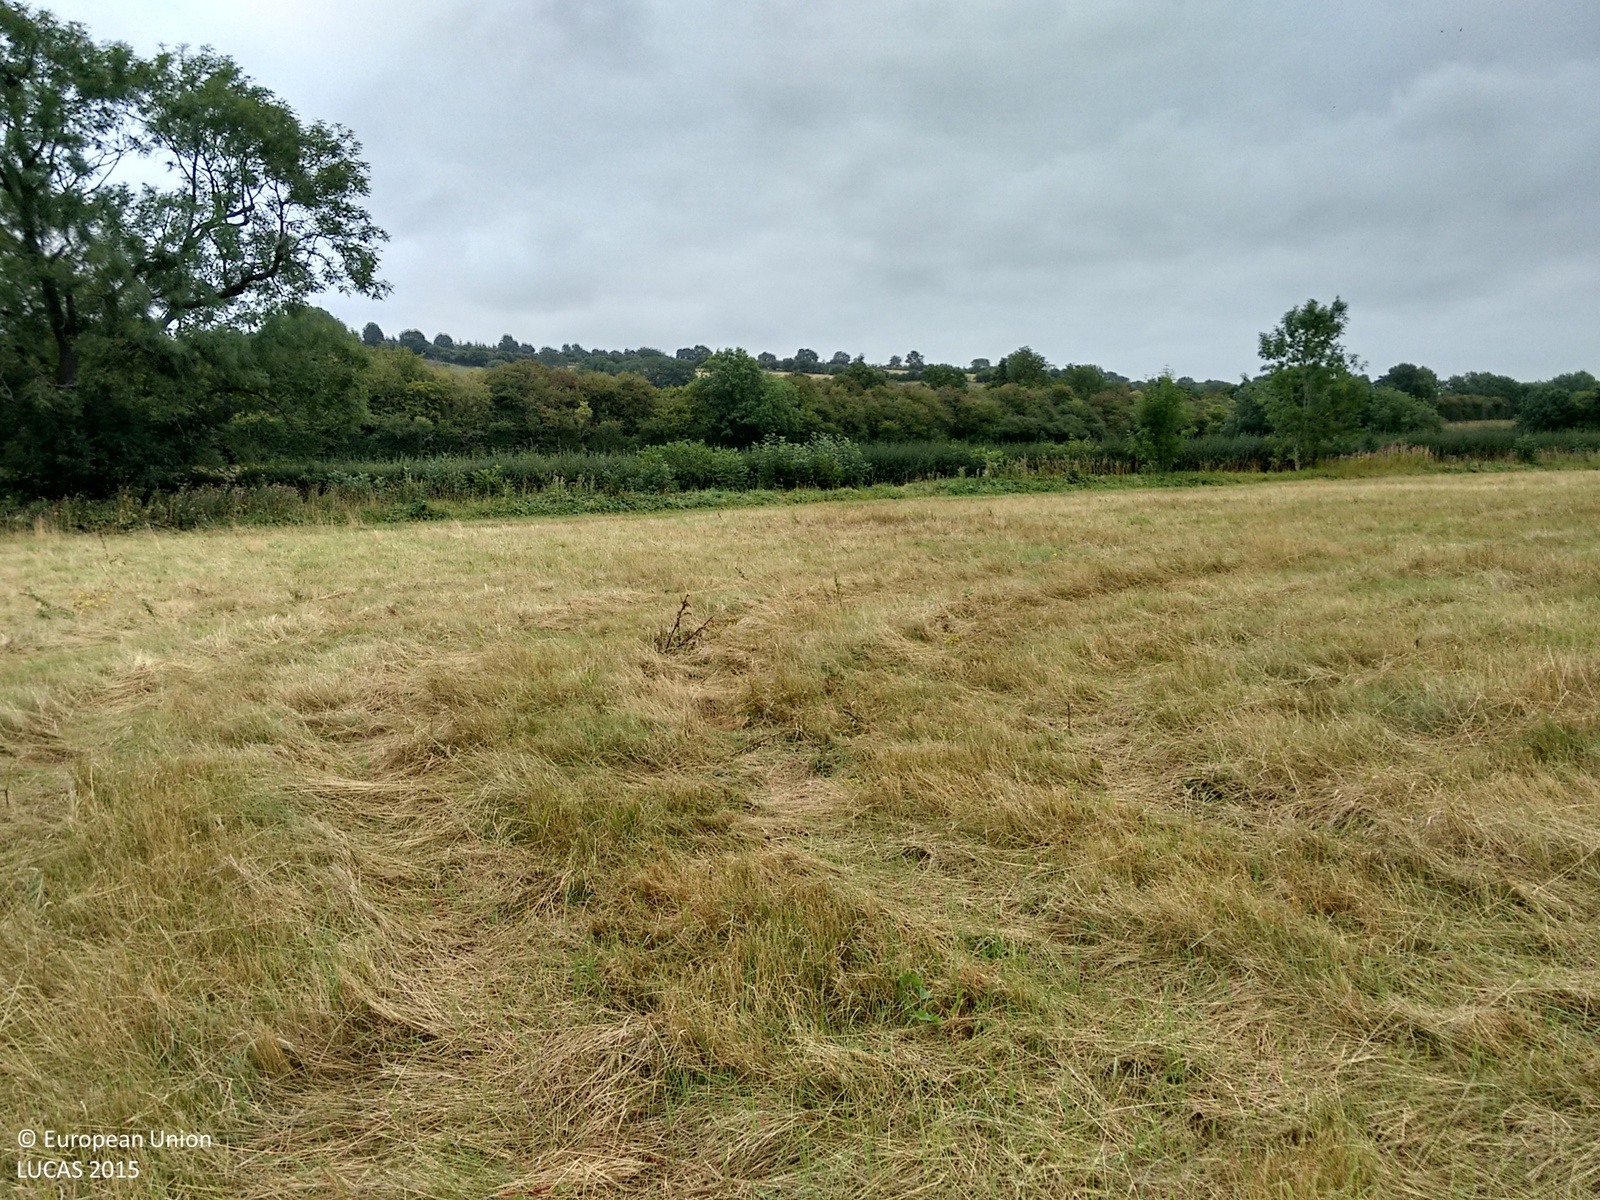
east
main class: Grassland
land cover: Grassland without tree/shrub cover
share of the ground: > 75 %
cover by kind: herbaceous plants 100 %
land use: Agriculture (excluding fallow land and kitchen gardens)
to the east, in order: Grassland without tree/shrub cover; Managed hedges; Grass margins; Dry pulses; Grass margins; Fences; Ditches and canals; Broadleaved woodland; Grass margins; Dry pulses
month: August
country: GB
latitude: 52.1543
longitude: -1.1991
